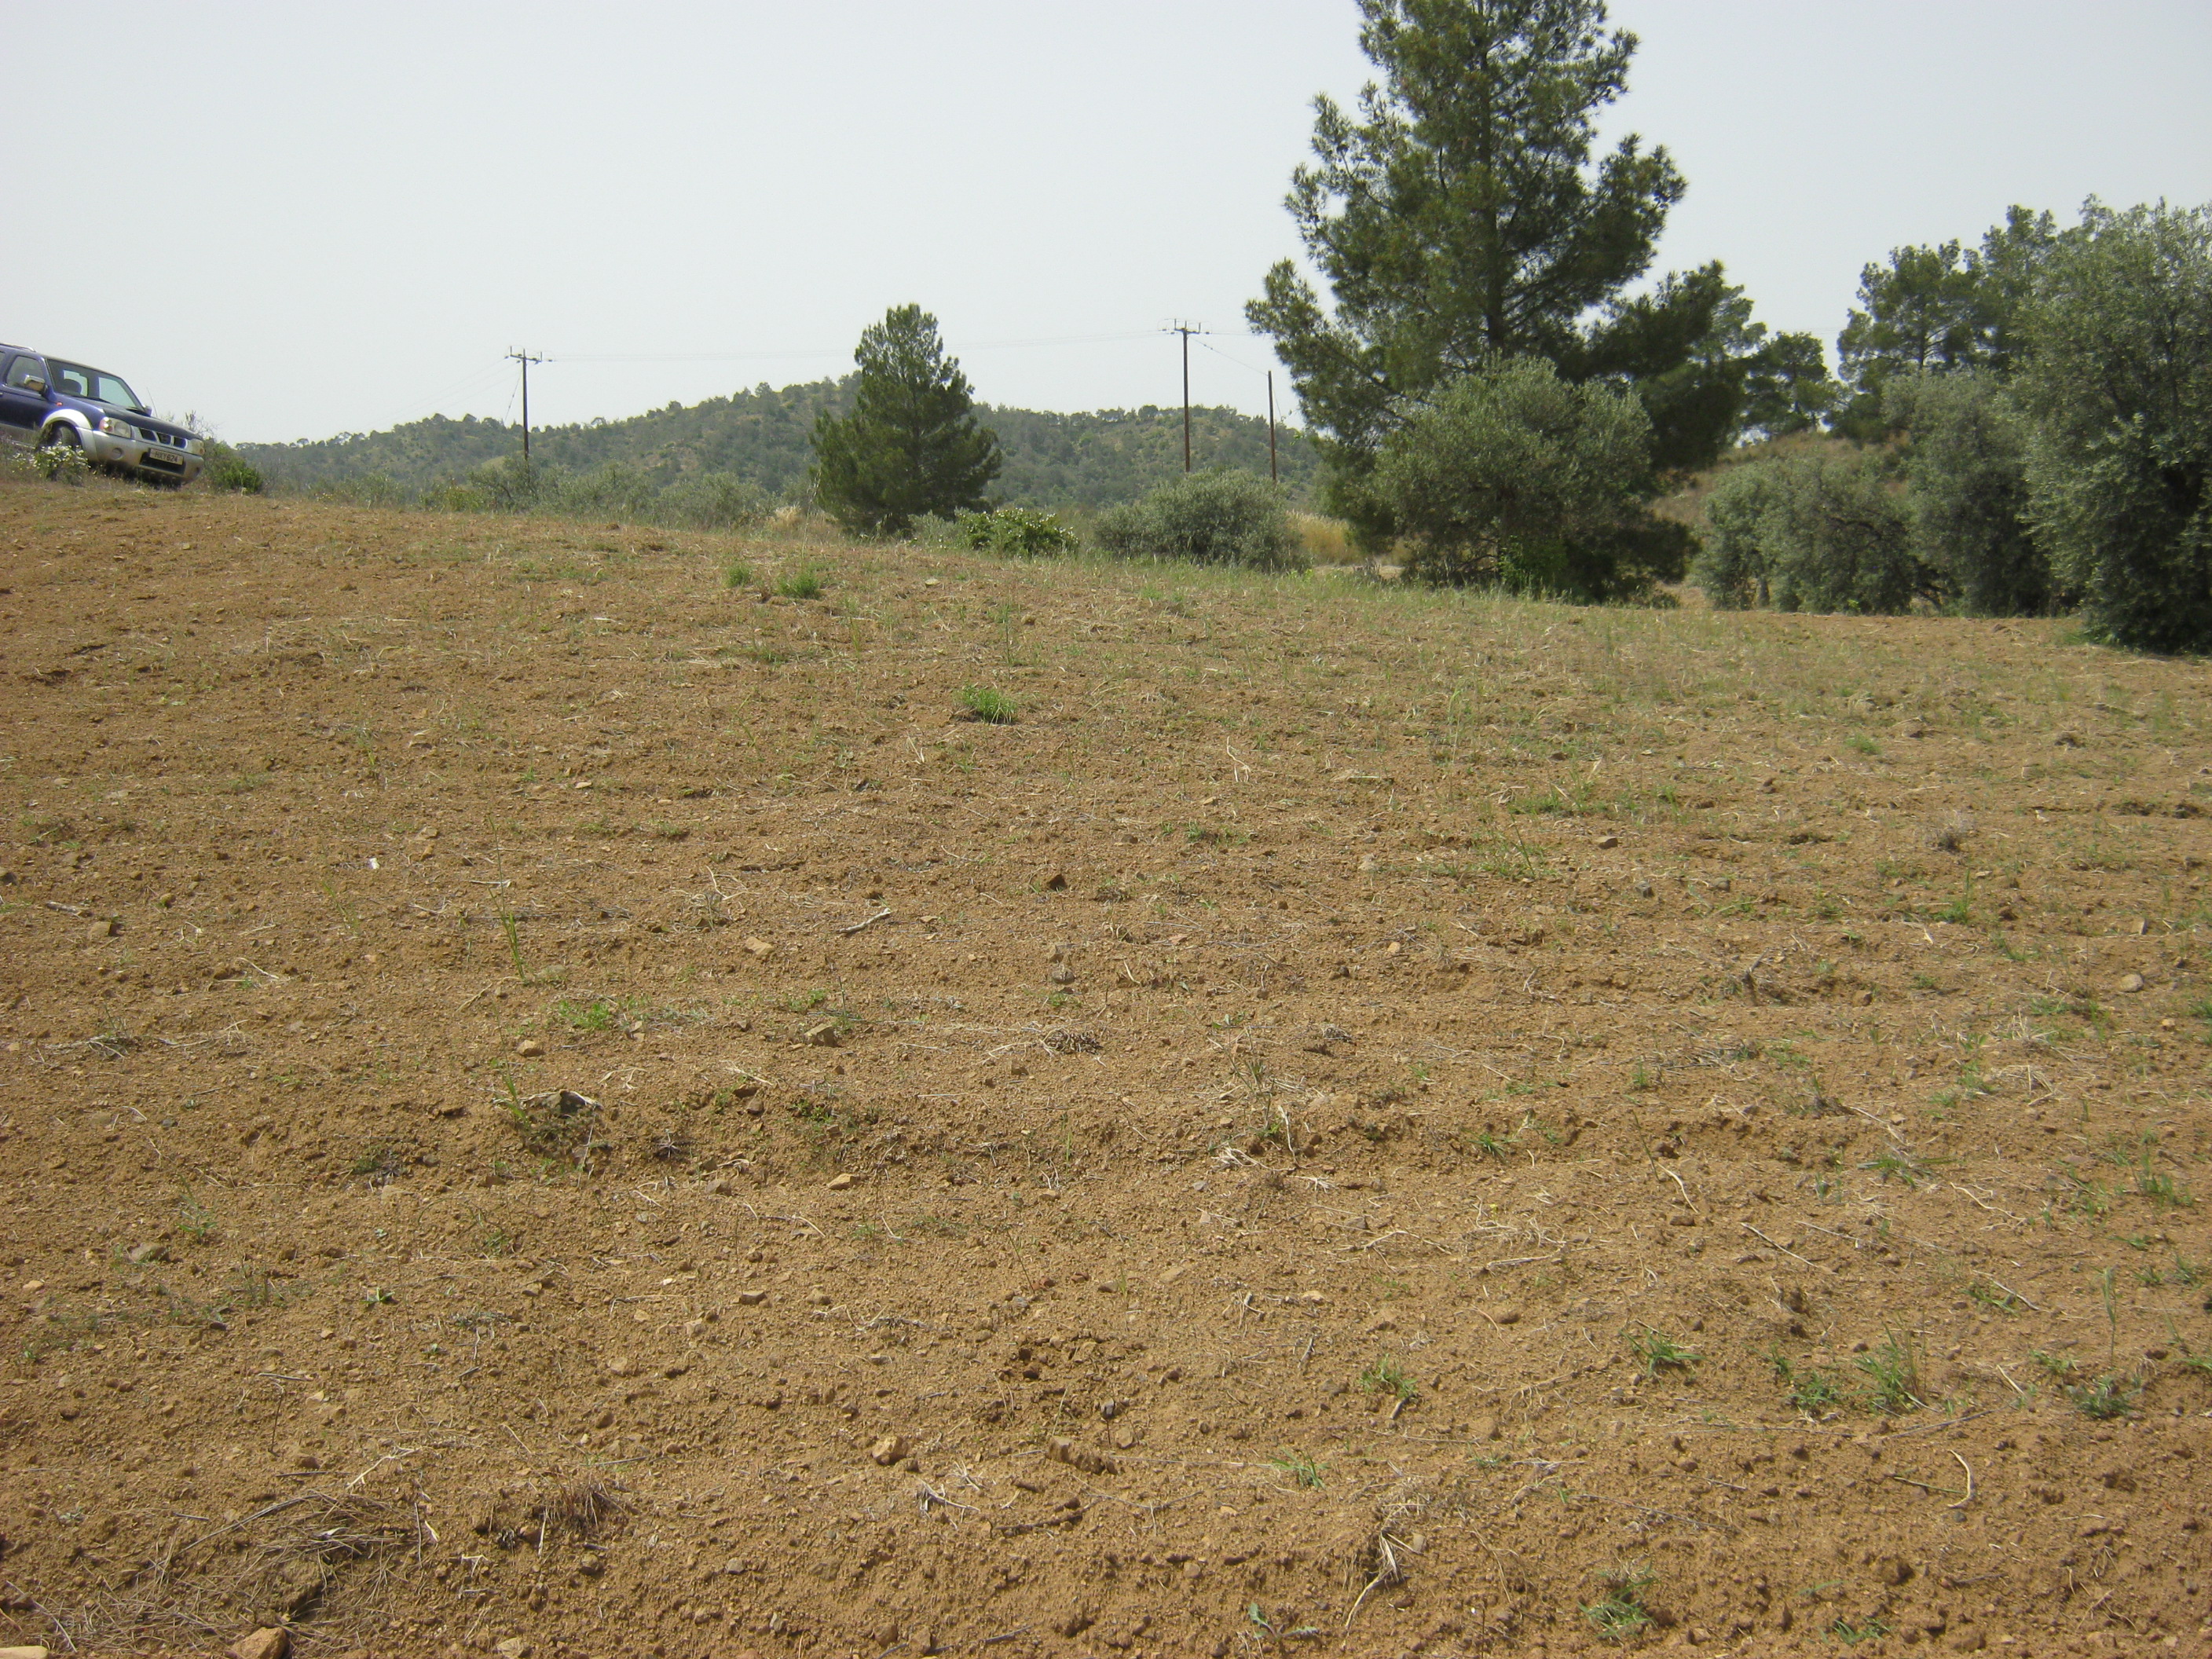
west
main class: Cropland
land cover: Other fruit trees and berries
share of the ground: < 10 %
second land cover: Other bare soil
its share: > 75 %
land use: Agriculture (excluding fallow land and kitchen gardens)
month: April
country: CY
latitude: 34.9653
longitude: 33.2819
